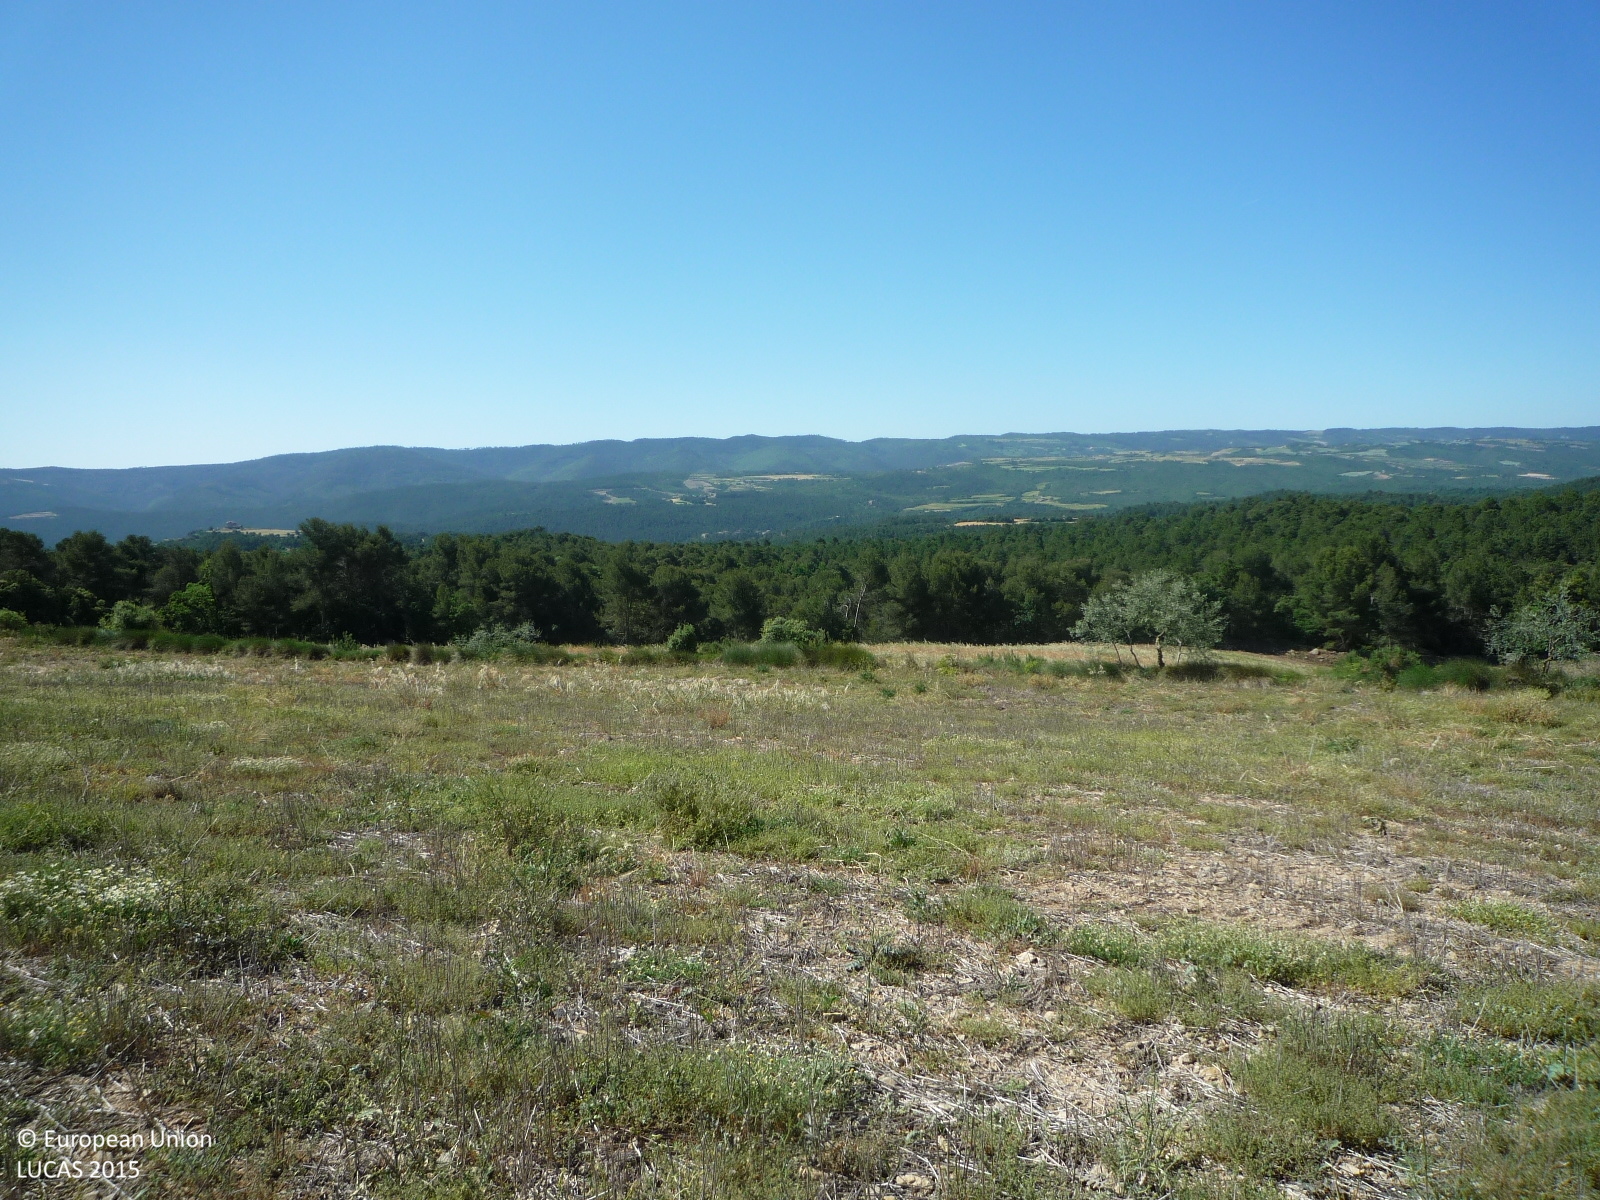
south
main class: Grassland
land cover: Spontaneously vegetated surfaces
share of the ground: > 75 %
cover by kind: herbaceous plants 100 %
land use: Agriculture (excluding fallow land and kitchen gardens)
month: May
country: ES
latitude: 41.8723
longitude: 1.6399
